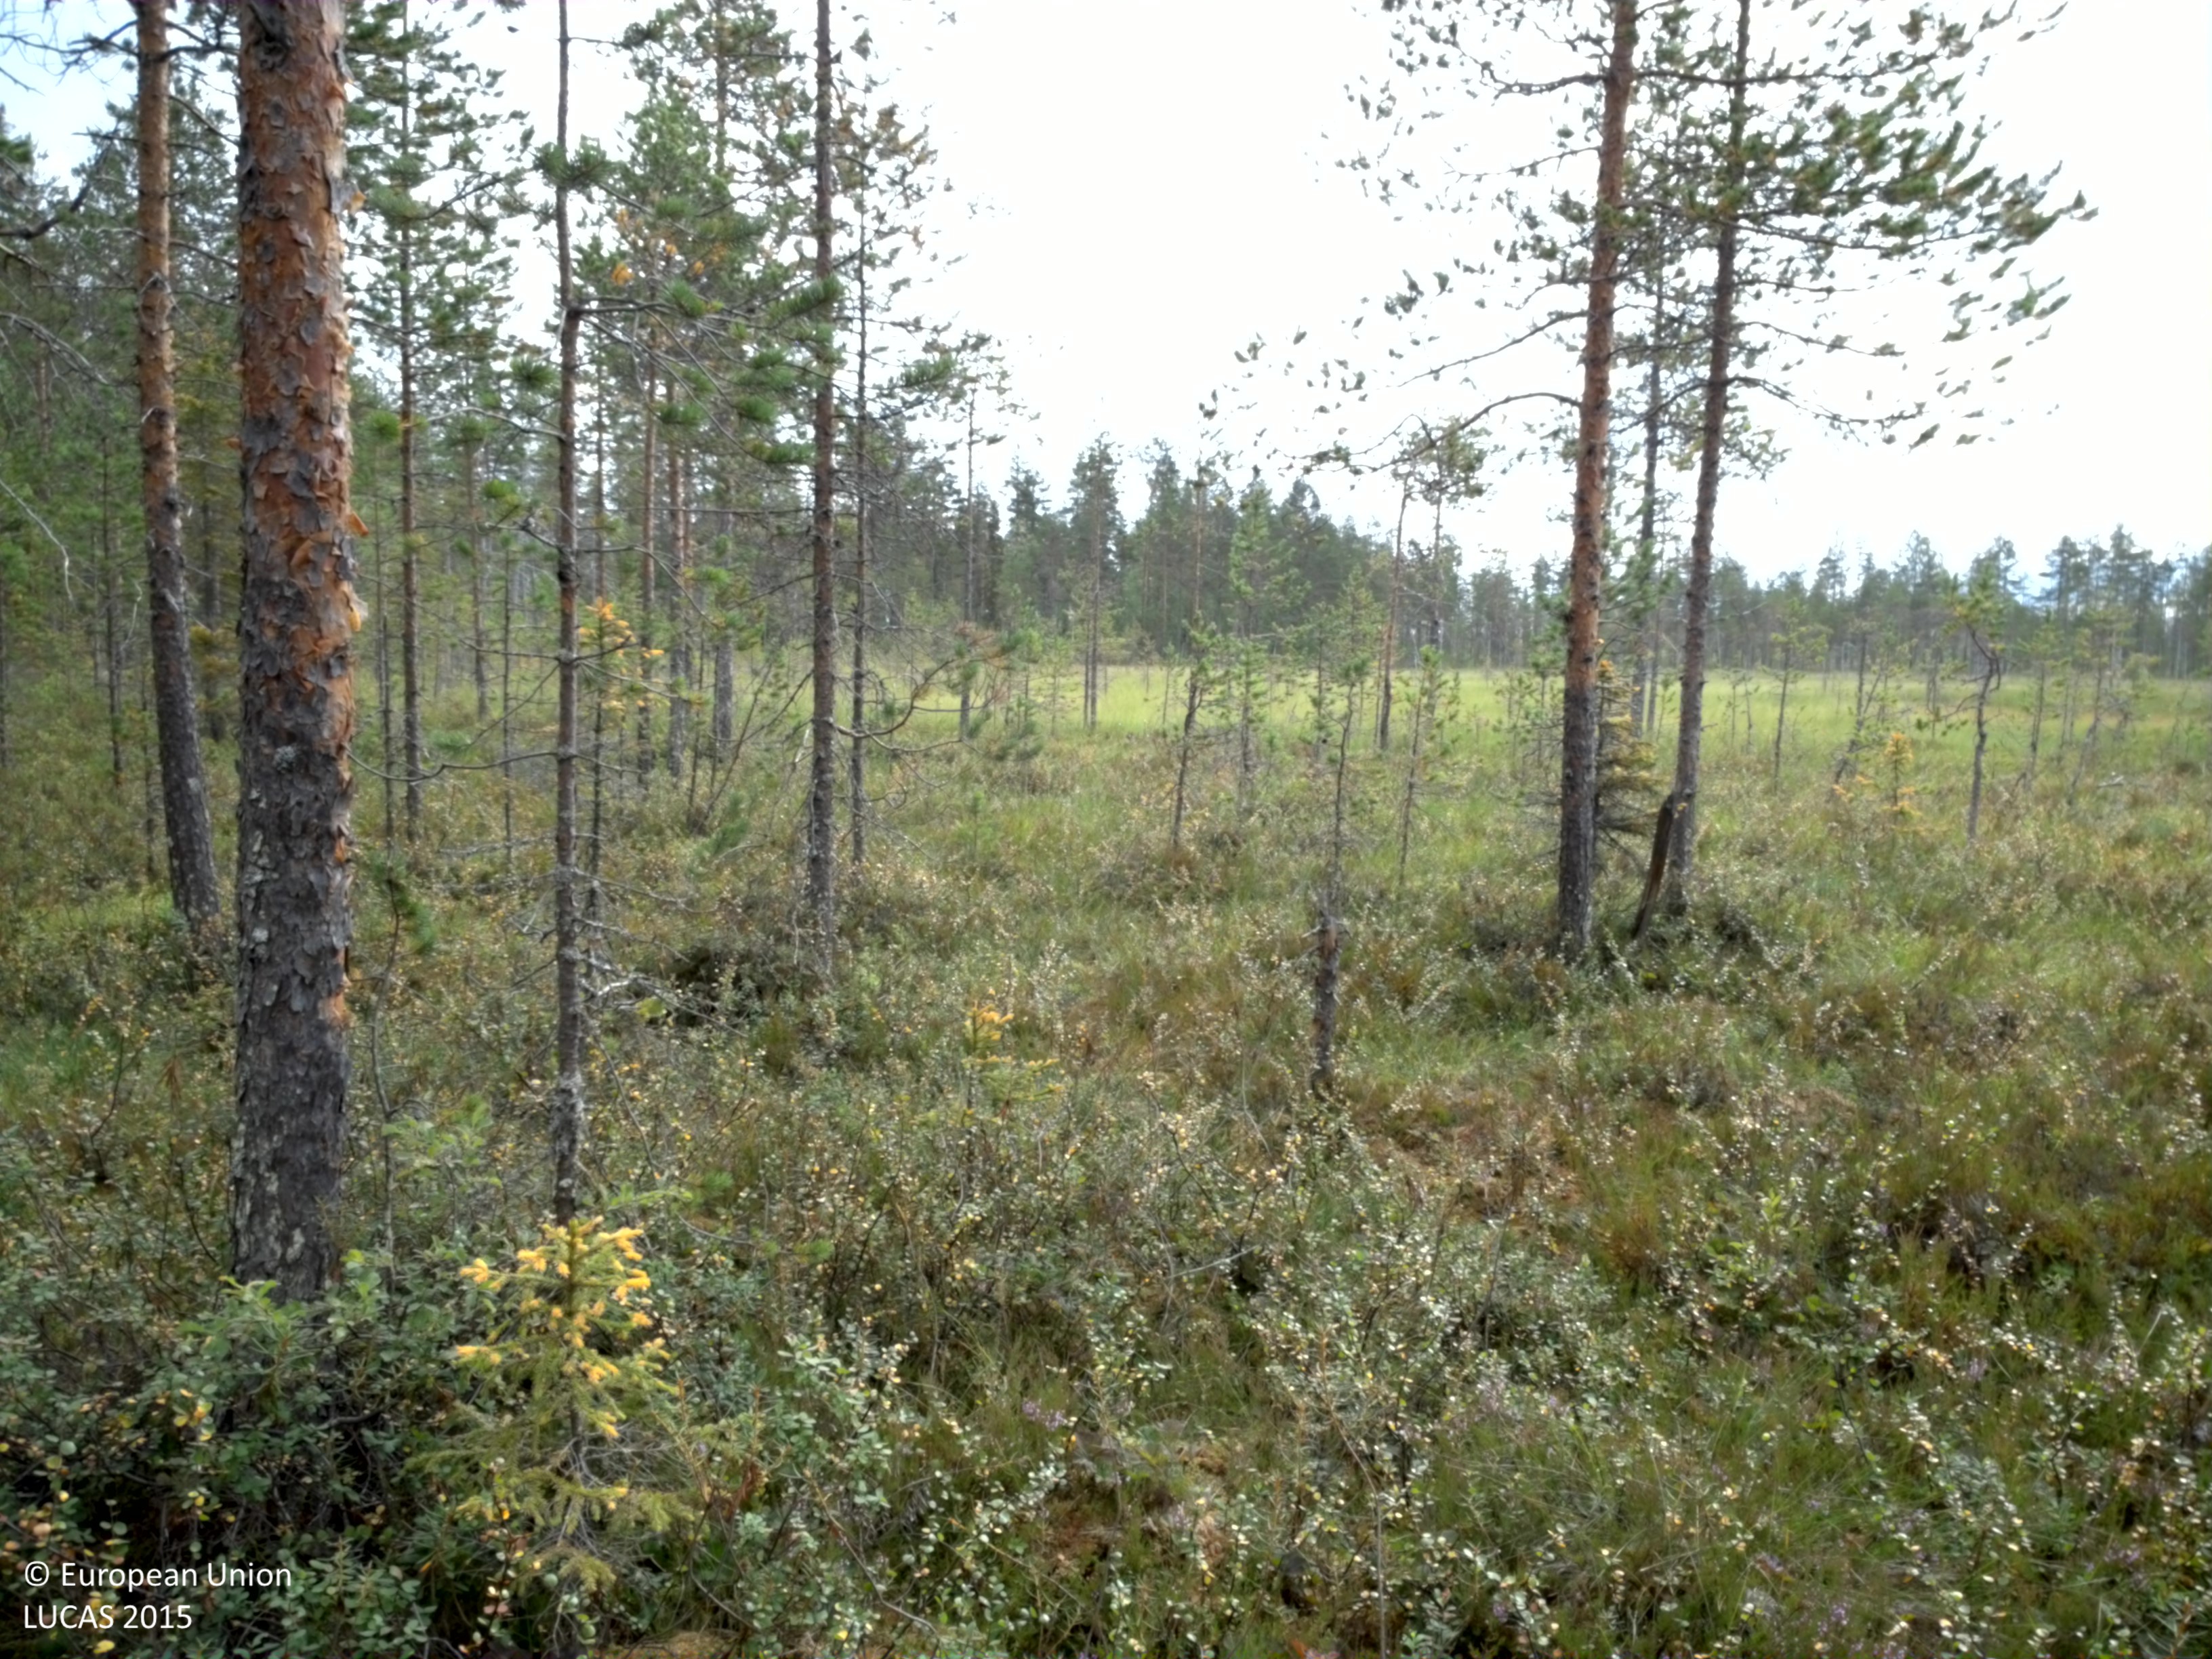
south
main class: Woodland
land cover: Pine dominated coniferous woodland
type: boreal forest
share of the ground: 25 - 50 %
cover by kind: shrubs 70 %, coniferous forest trees 25 %, lichens and mosses 5 %
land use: Forestry
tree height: > 5 m
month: August
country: SE
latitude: 65.9927
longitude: 22.5118
